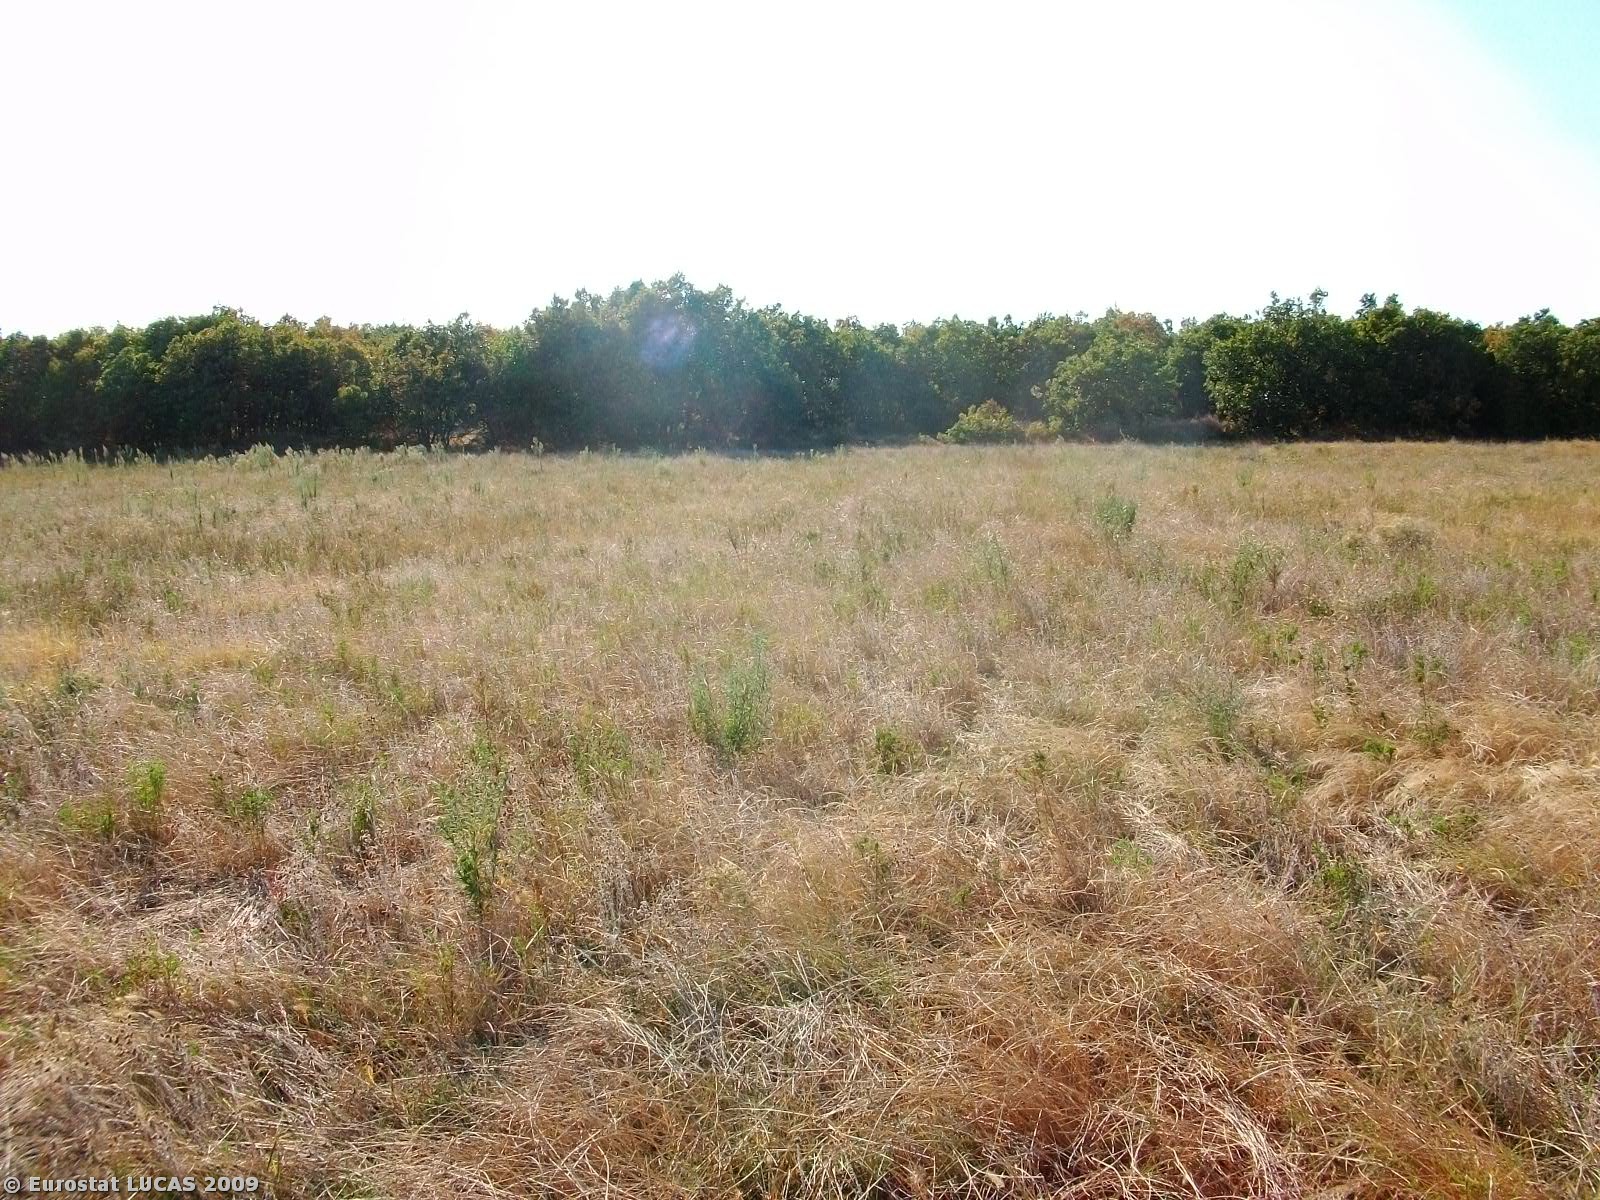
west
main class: Grassland
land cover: Grassland without tree/shrub cover
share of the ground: > 75 %
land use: Fallow land
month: August
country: GR
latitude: 41.3103
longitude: 26.3778
